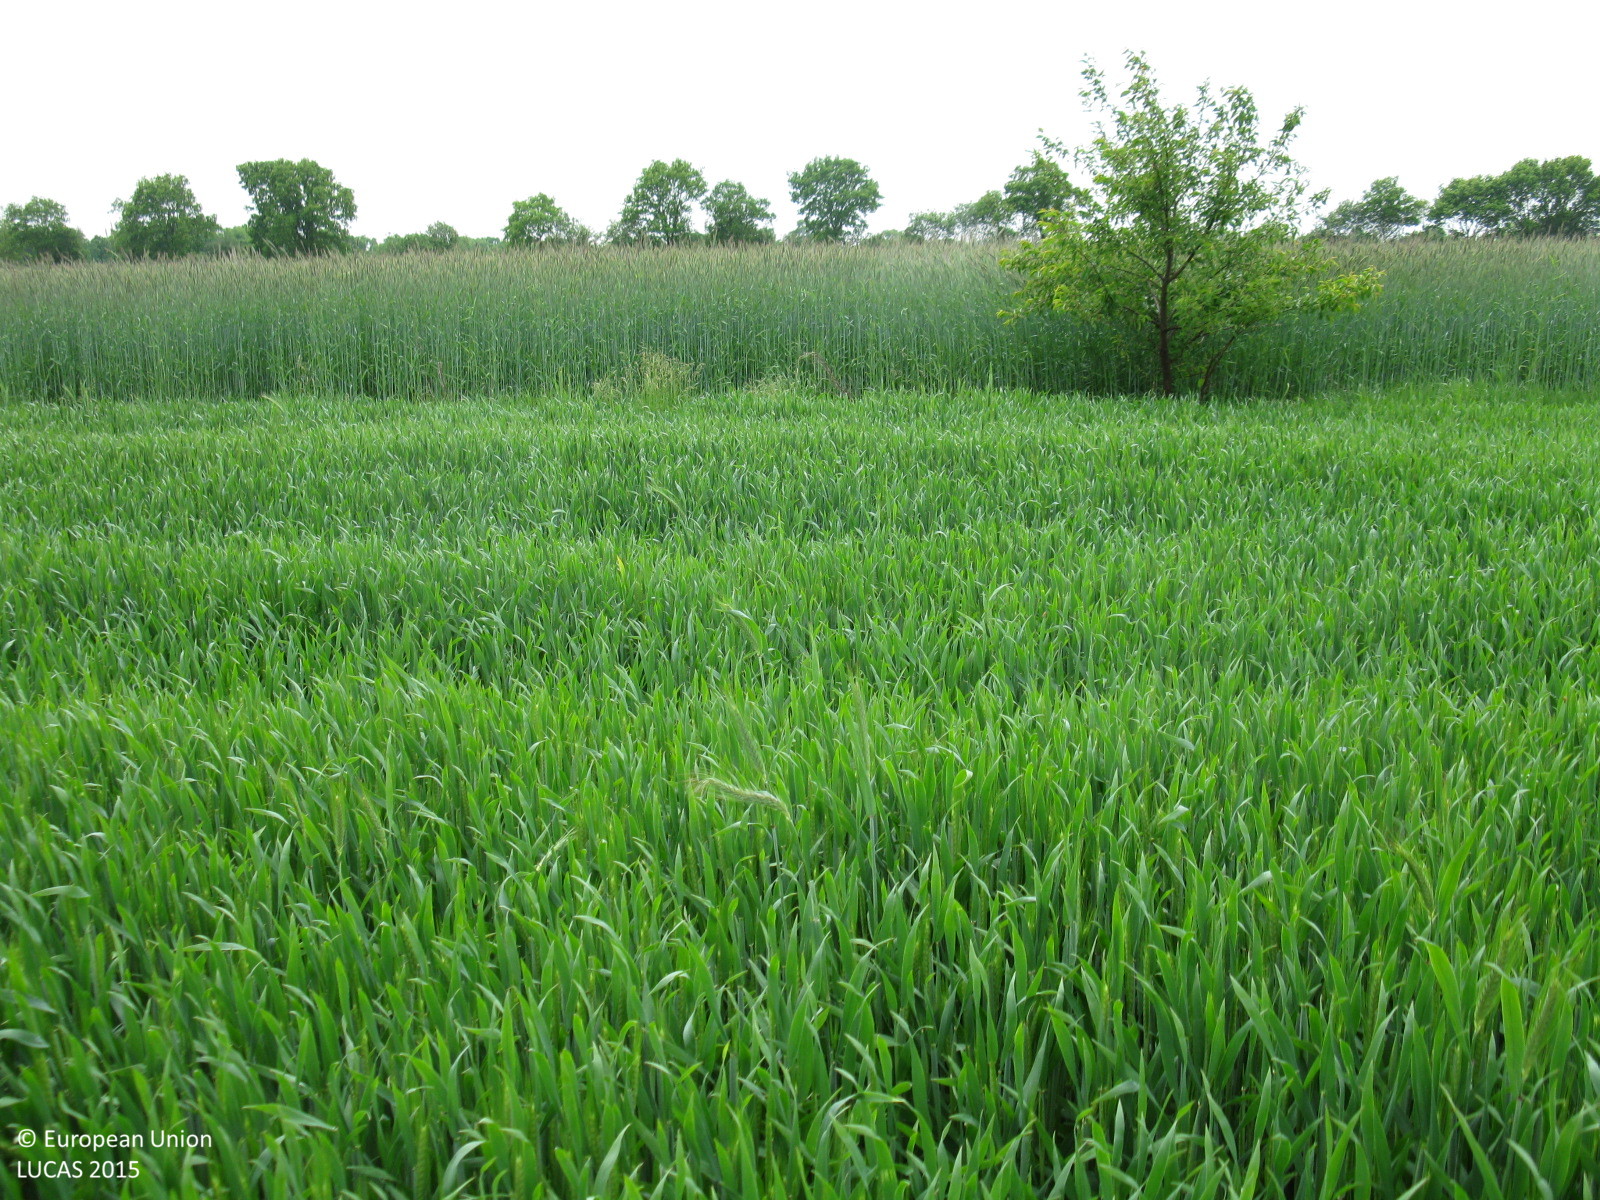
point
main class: Cropland
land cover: Triticale
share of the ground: > 75 %
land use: Agriculture (excluding fallow land and kitchen gardens)
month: May
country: DE
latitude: 52.9963
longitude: 7.3931
